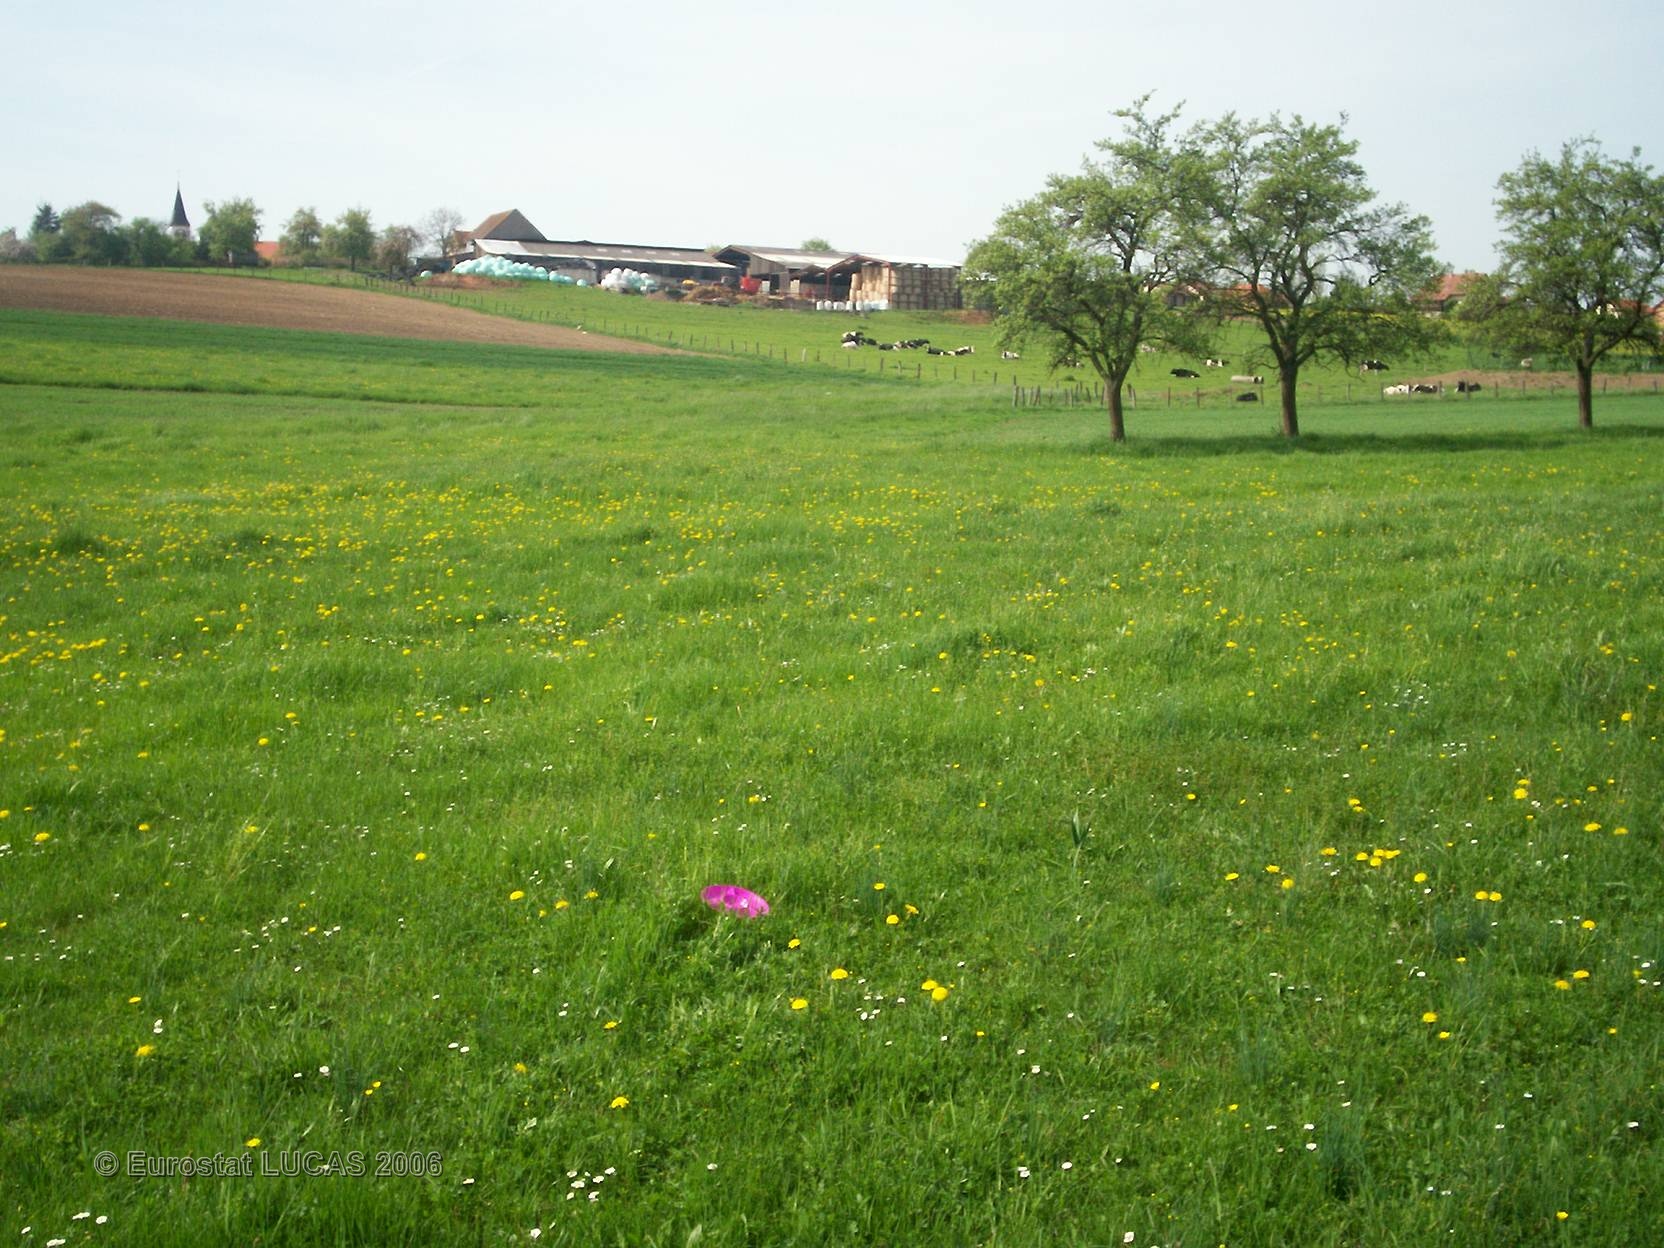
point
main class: Grassland
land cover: Grassland without tree/shrub cover
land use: Agriculture (excluding fallow land and kitchen gardens)
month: May
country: FR
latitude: 48.9565
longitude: 6.9823
